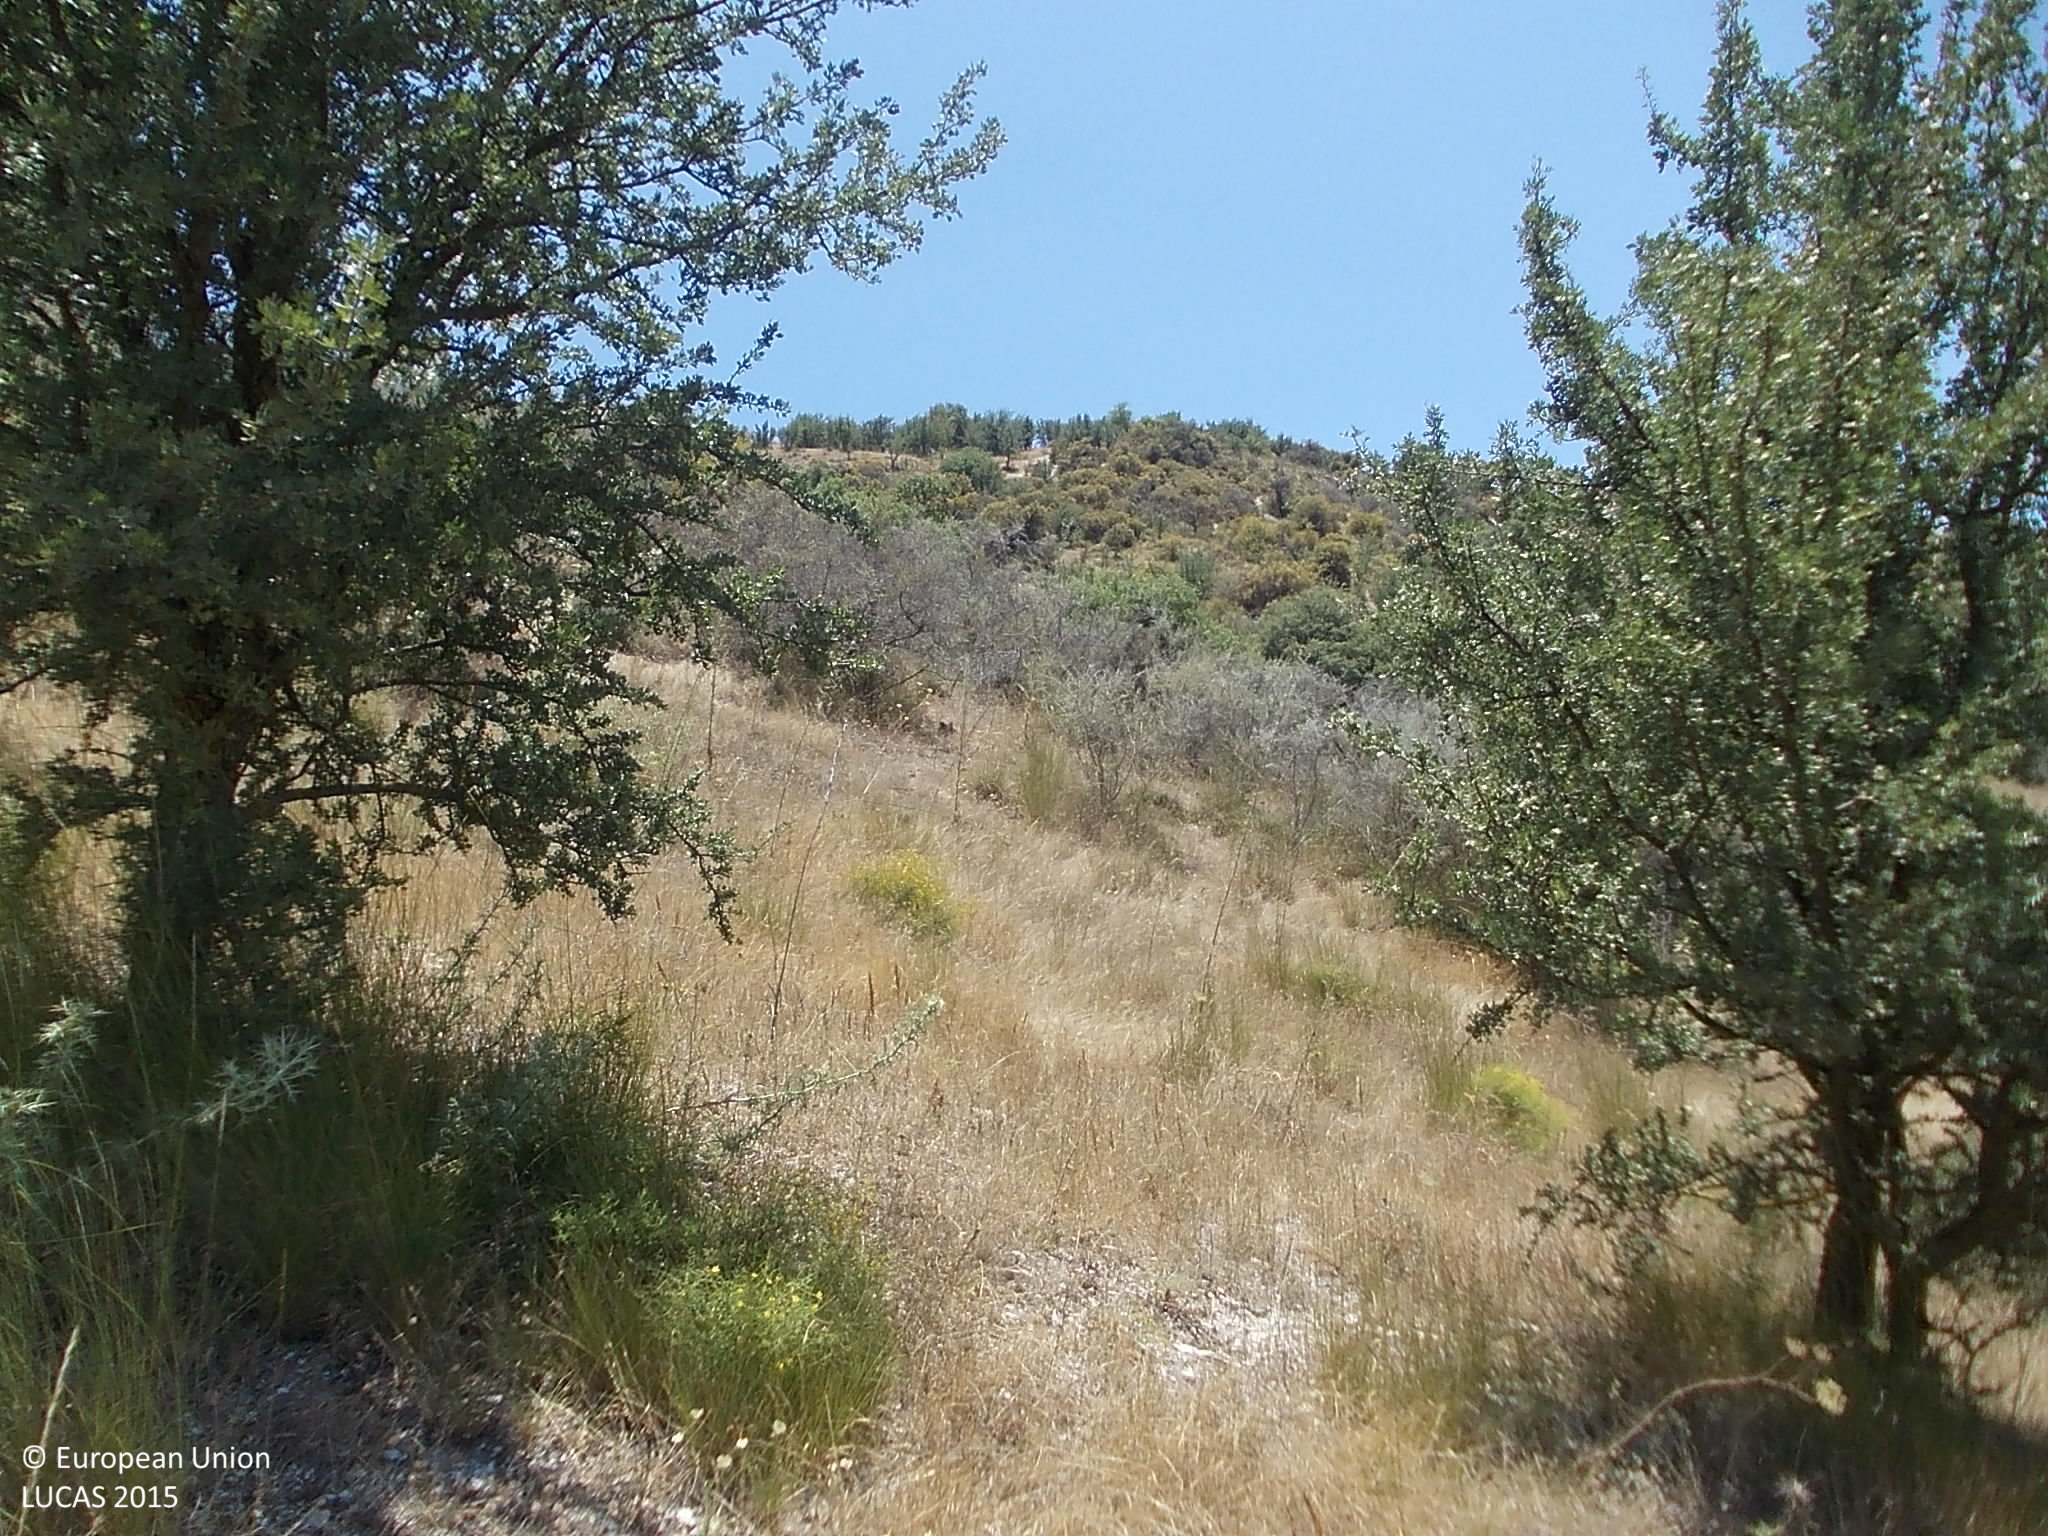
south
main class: Grassland
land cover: Grassland with sparse tree/shrub cover
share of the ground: > 75 %
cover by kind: herbaceous plants 85 %, broadleaved forest trees 5 %, shrubs 5 %, unconsolidated bare surface 5 %
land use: Semi-natural and natural areas not in use
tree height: < 5 m
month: July
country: CY
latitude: 34.8064
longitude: 32.7297
